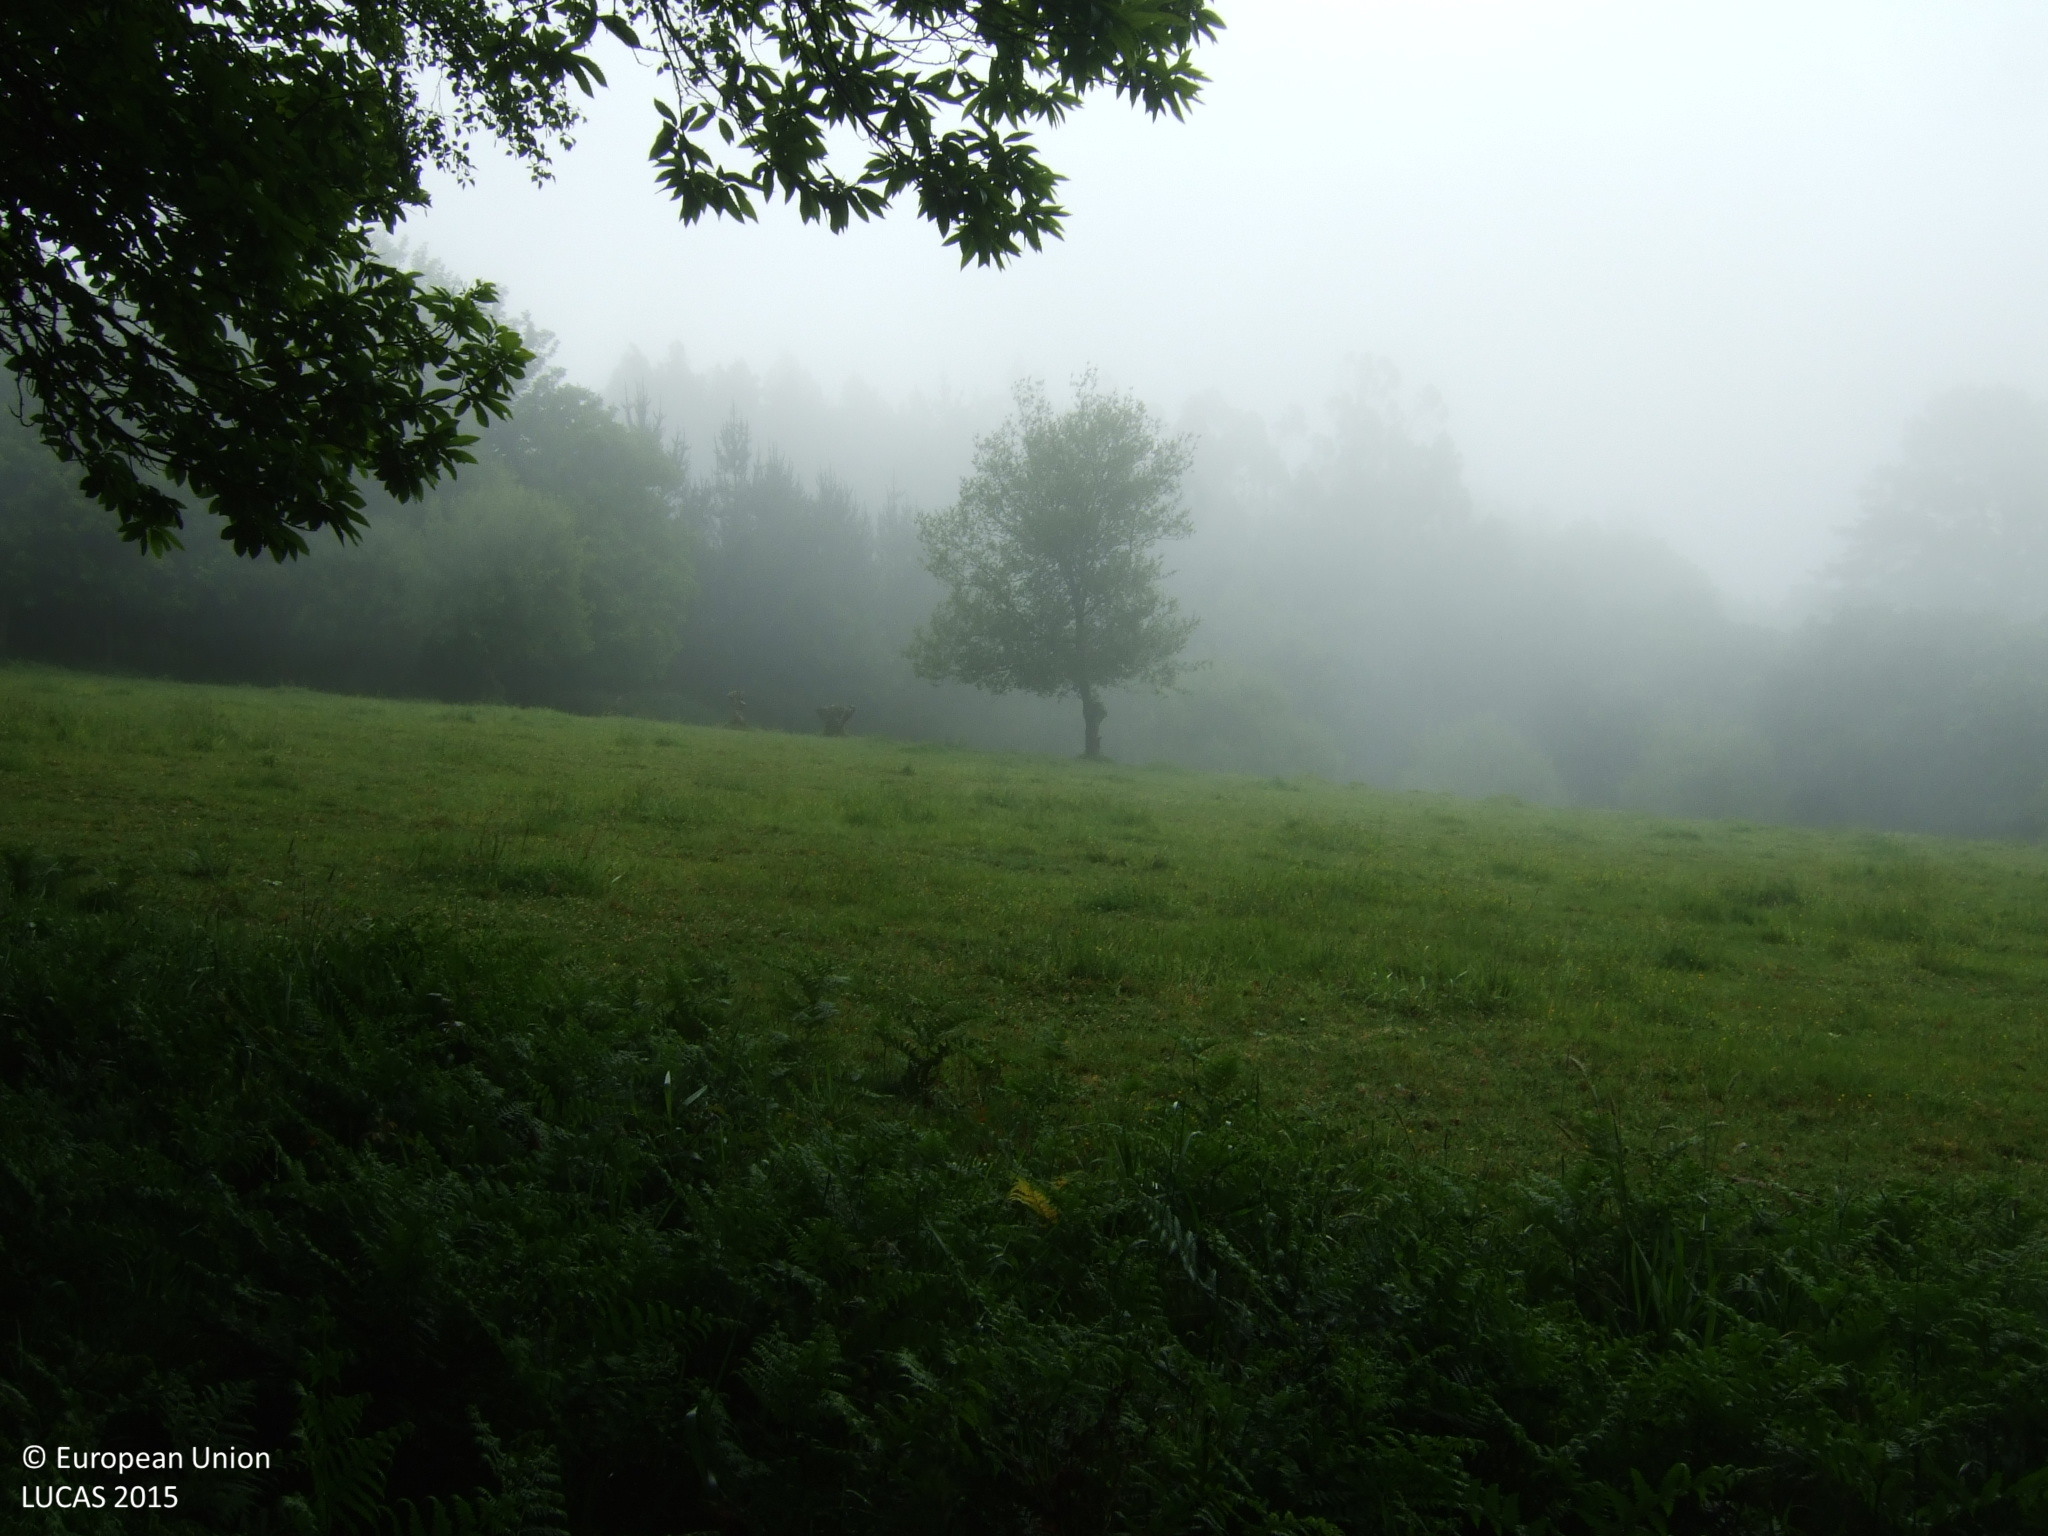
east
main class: Woodland
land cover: Broadleaved woodland
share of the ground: 50 - 75 %
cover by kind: broadleaved forest trees 65 %, shrubs 35 %
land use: Forestry
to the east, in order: Broadleaved woodland; Electric lines; Grassland without tree/shrub cover; Groves; Grassland without tree/shrub cover; Pine dominated coniferous woodland; Groves; Grassland without tree/shrub cover; Pine dominated mixed woodland
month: June
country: ES
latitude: 43.3315
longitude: -7.4812
